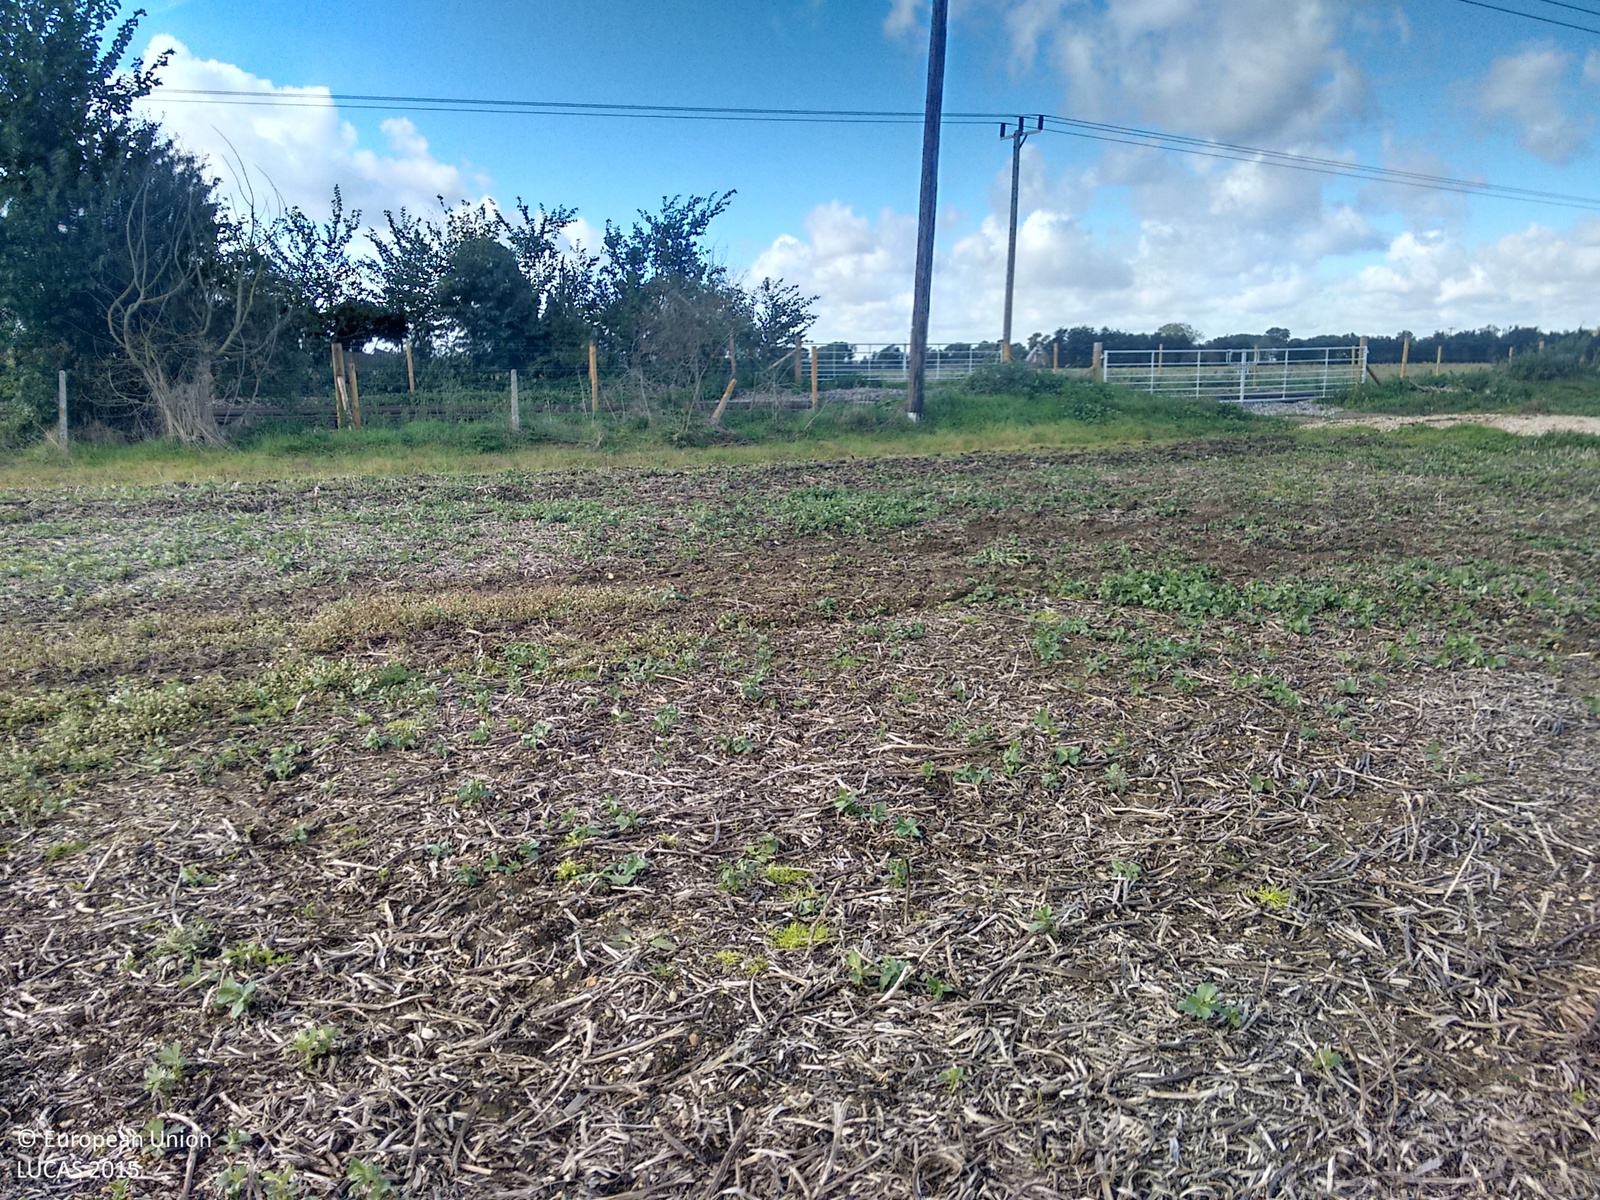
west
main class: Cropland
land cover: Dry pulses
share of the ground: 50 - 75 %
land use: Agriculture (excluding fallow land and kitchen gardens)
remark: Harvested field
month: September
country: GB
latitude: 52.1216
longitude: 0.0507
